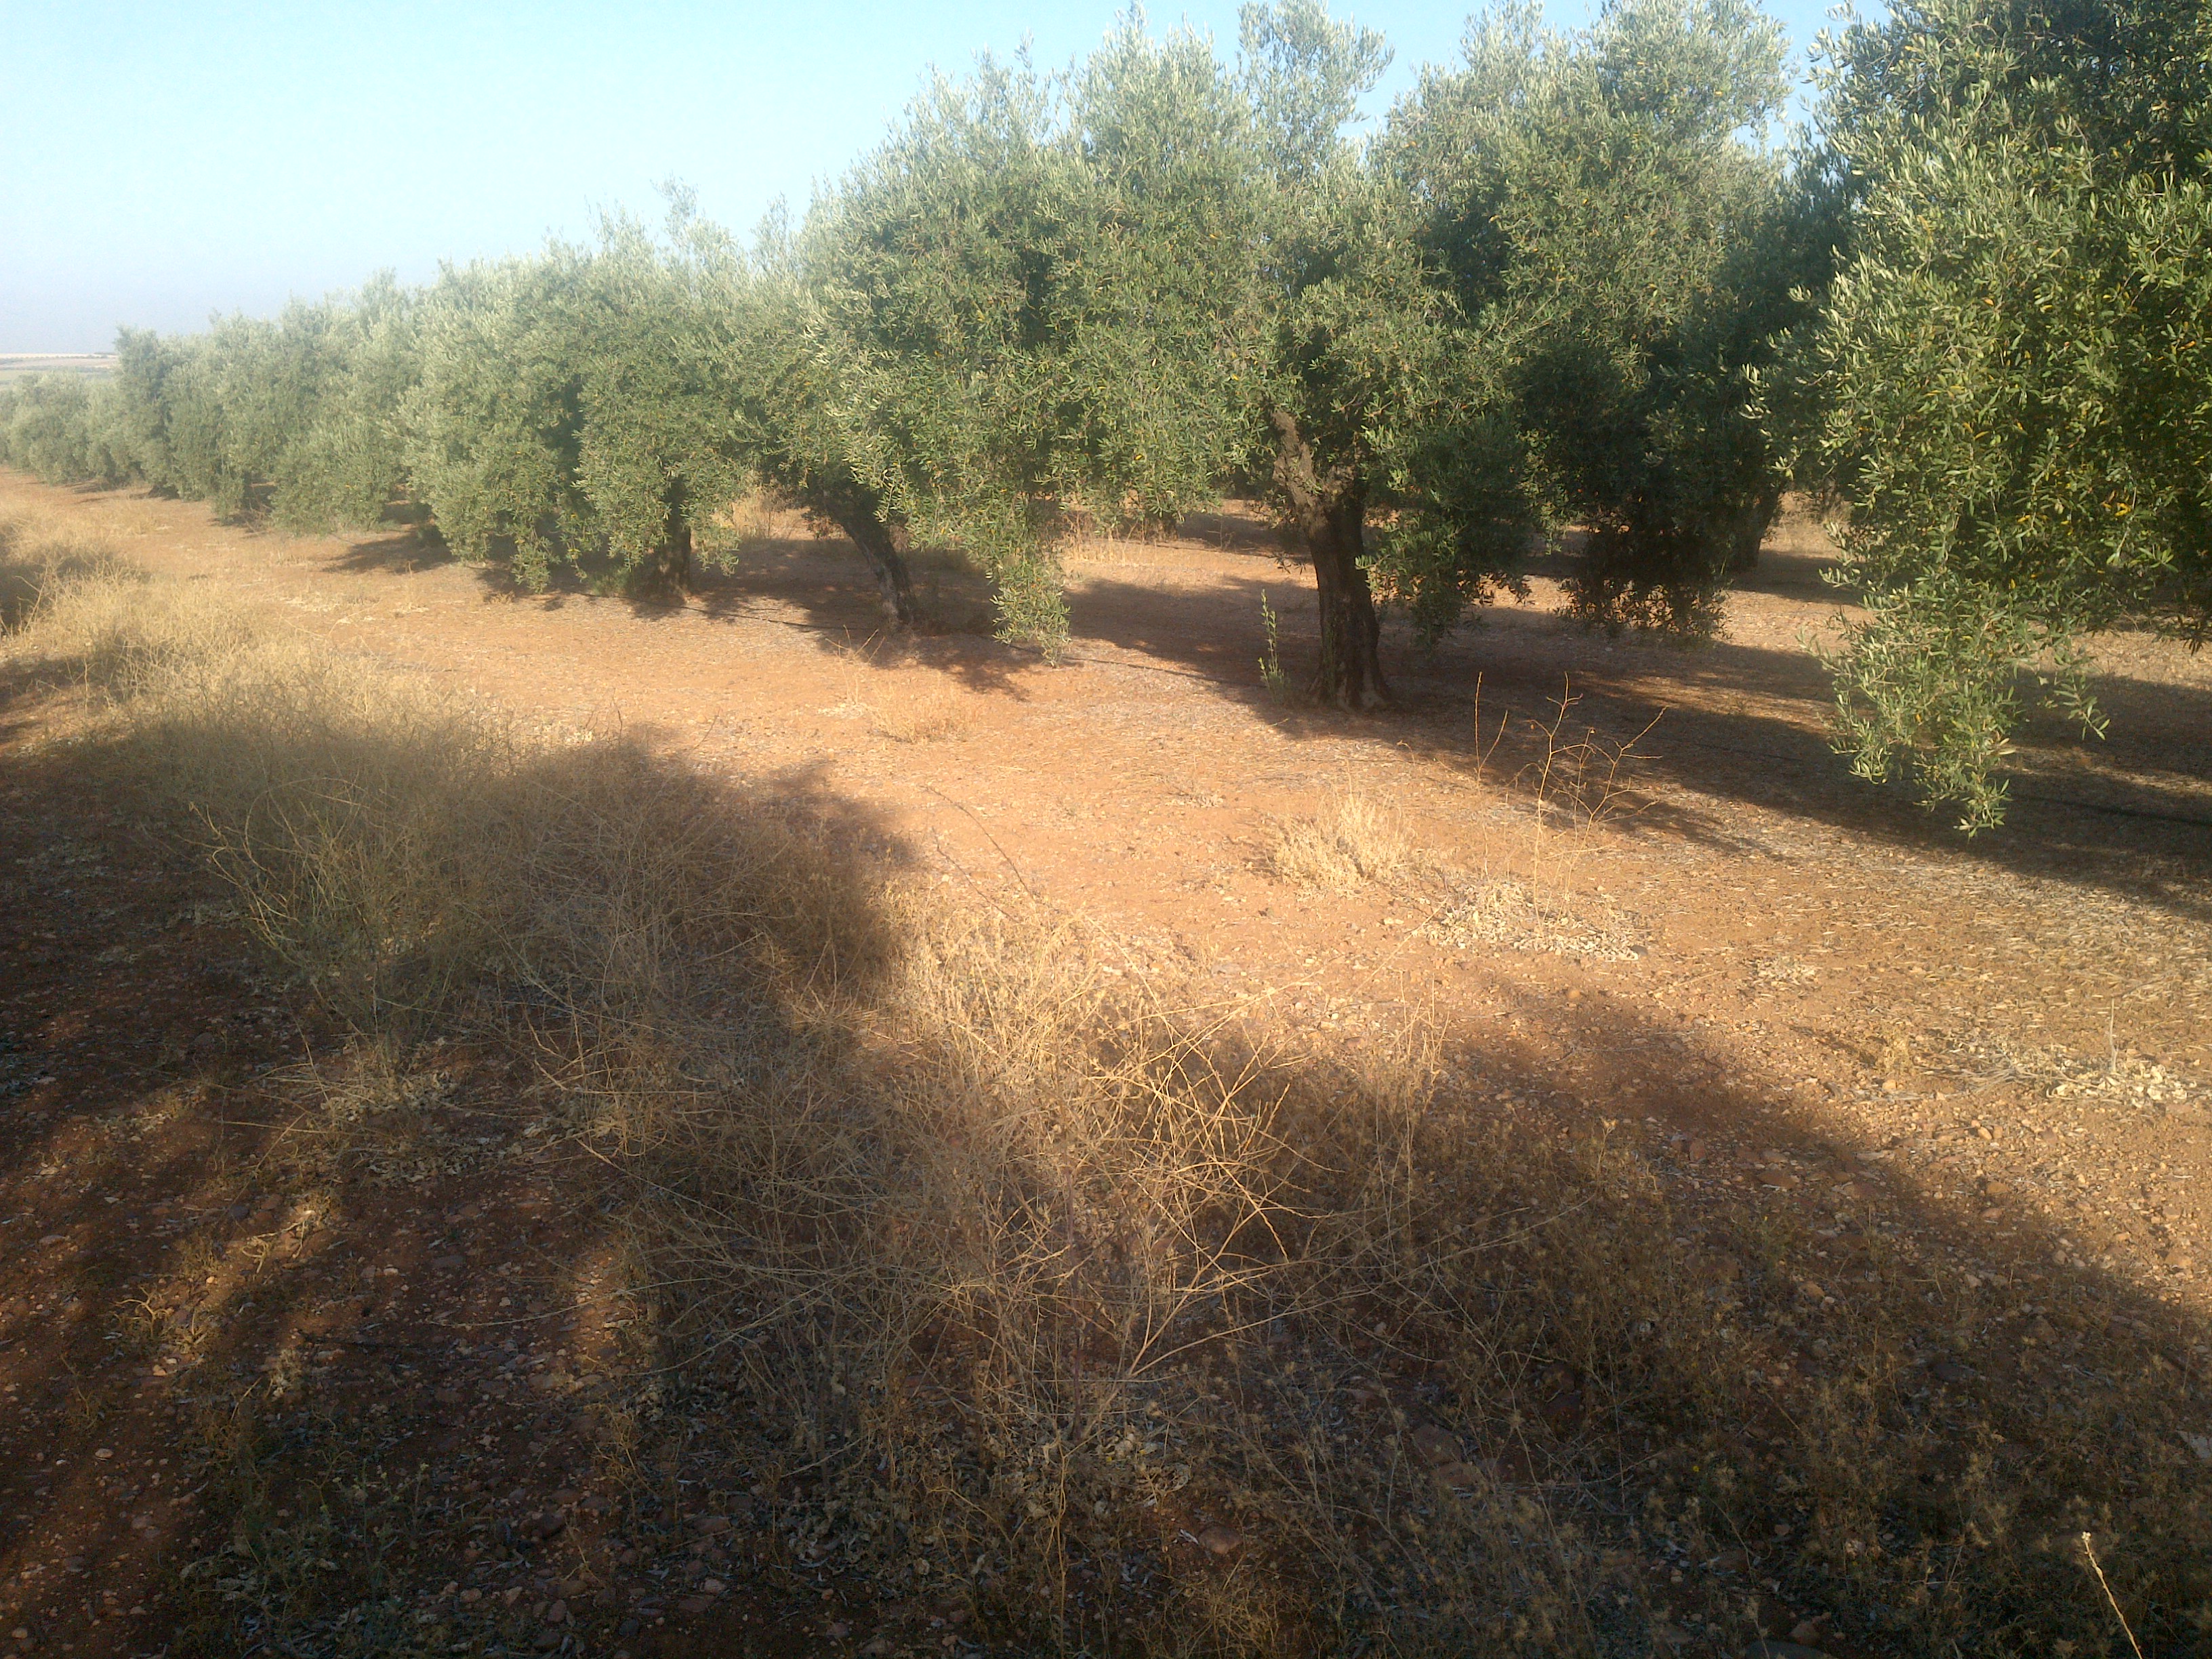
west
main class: Cropland
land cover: Olive groves
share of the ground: 50 - 75 %
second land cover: Spontaneously vegetated surfaces
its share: 10 - 25 %
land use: Agriculture (excluding fallow land and kitchen gardens)
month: June
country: ES
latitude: 37.6317
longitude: -4.9128
